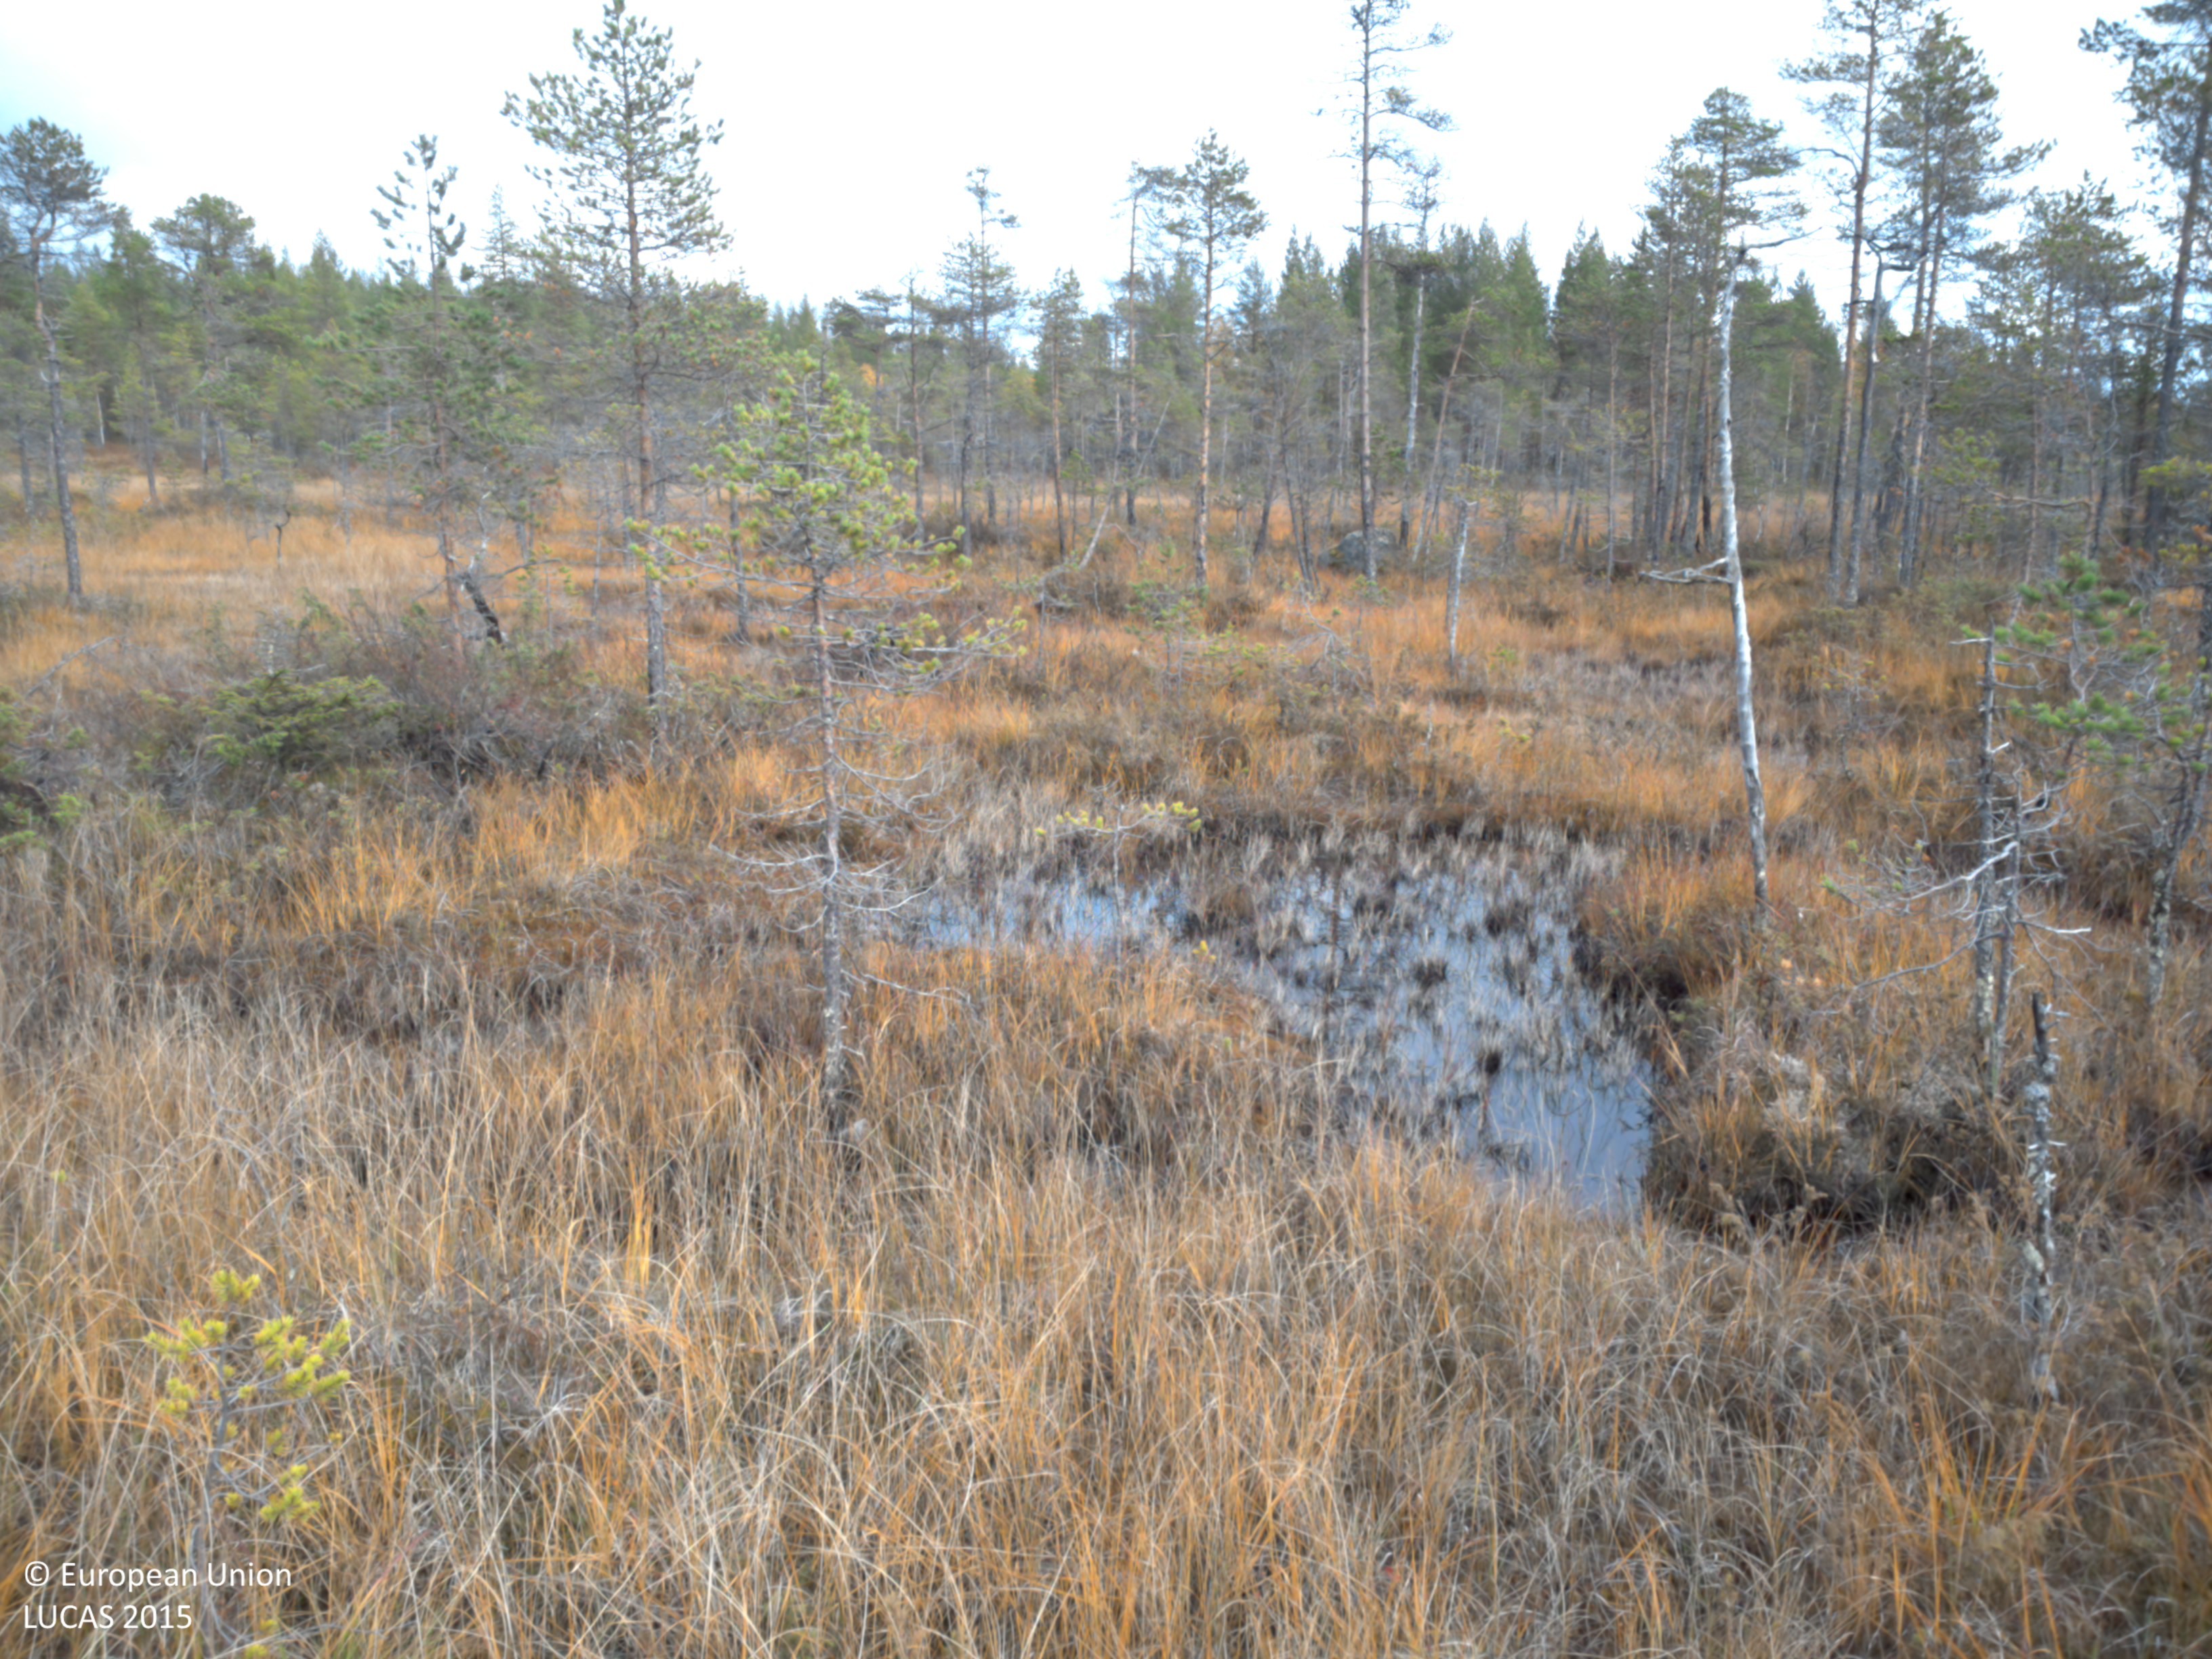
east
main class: Woodland
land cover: Pine dominated coniferous woodland
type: boreal forest
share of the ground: 25 - 50 %
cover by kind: coniferous forest trees 50 %, shrubs 20 %, herbaceous plants 15 %, lichens and mosses 15 %
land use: Semi-natural and natural areas not in use
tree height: < 5 m
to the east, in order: Pine dominated coniferous woodland; Pine dominated mixed woodland; Inland marshes; Pine dominated coniferous woodland
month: September
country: SE
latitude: 64.7262
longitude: 18.9733
